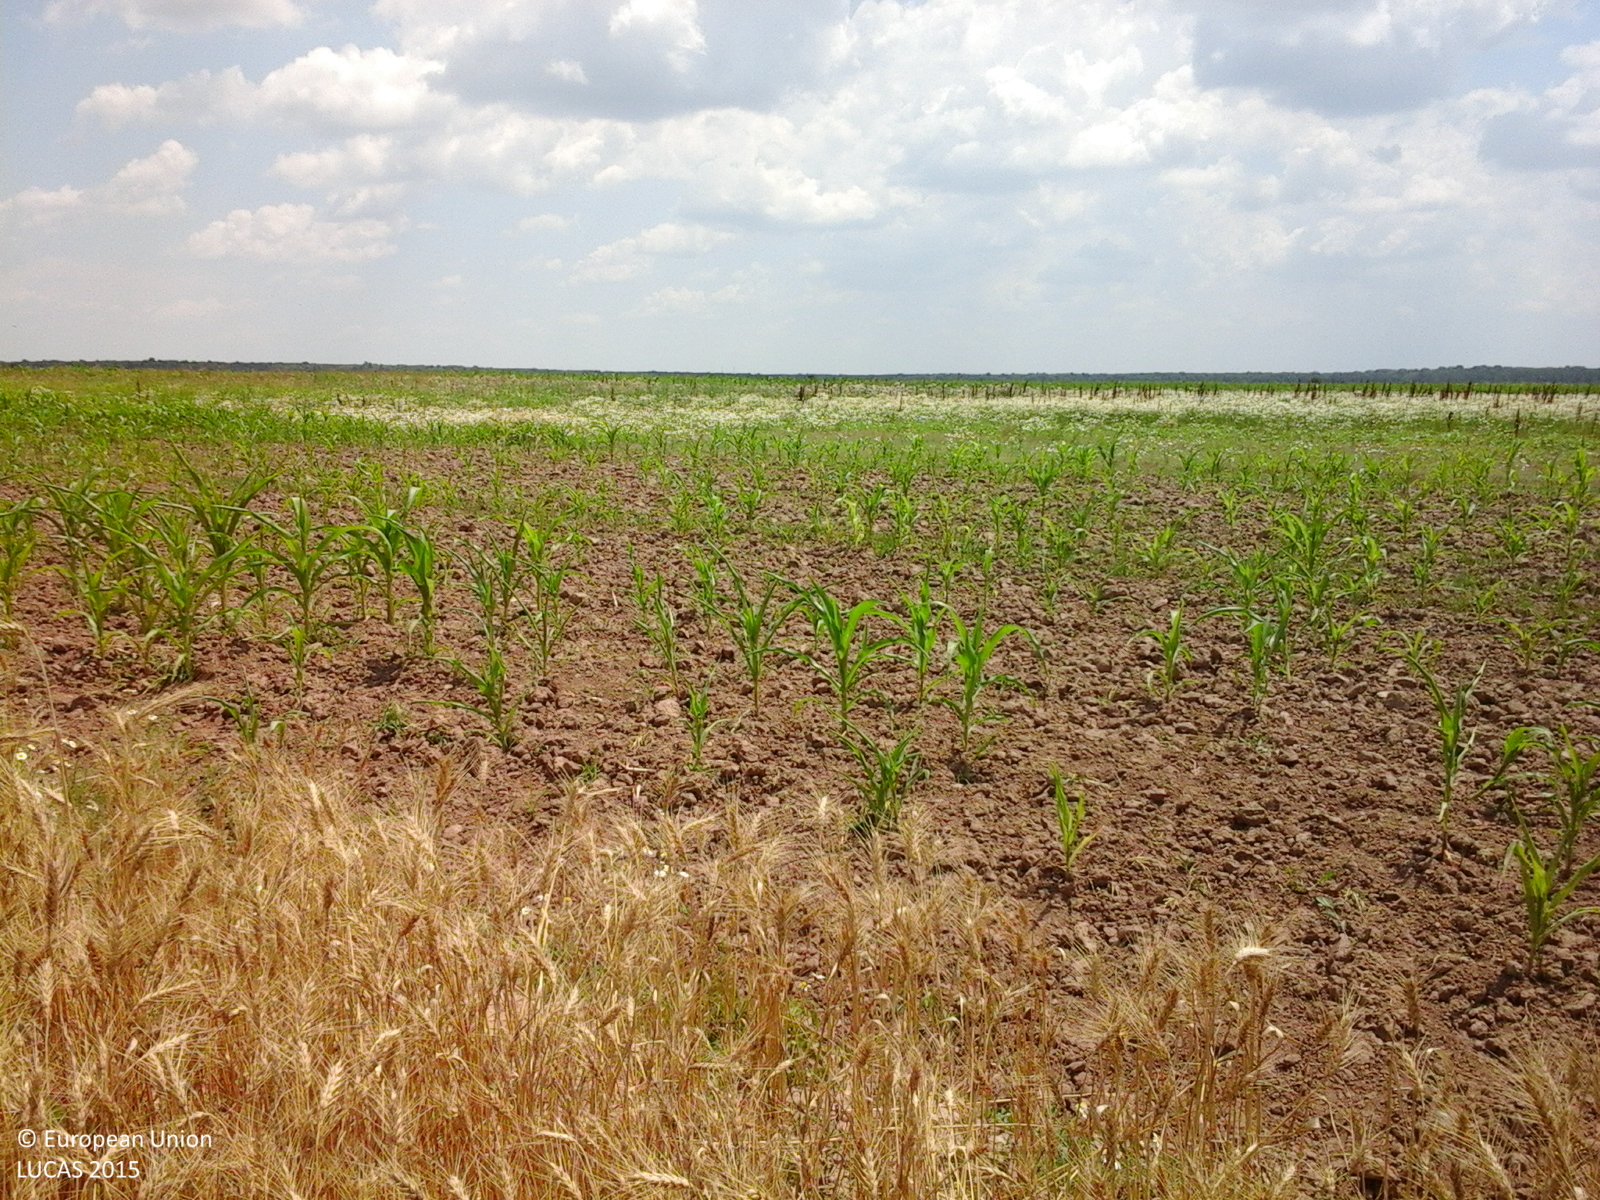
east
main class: Cropland
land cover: Common wheat
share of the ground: > 75 %
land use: Agriculture (excluding fallow land and kitchen gardens)
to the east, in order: Common wheat; Maize; Spontaneously vegetated surfaces; Tracks; Common wheat; Maize; Spontaneously vegetated surfaces
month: July
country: RO
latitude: 44.4405
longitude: 25.6362
